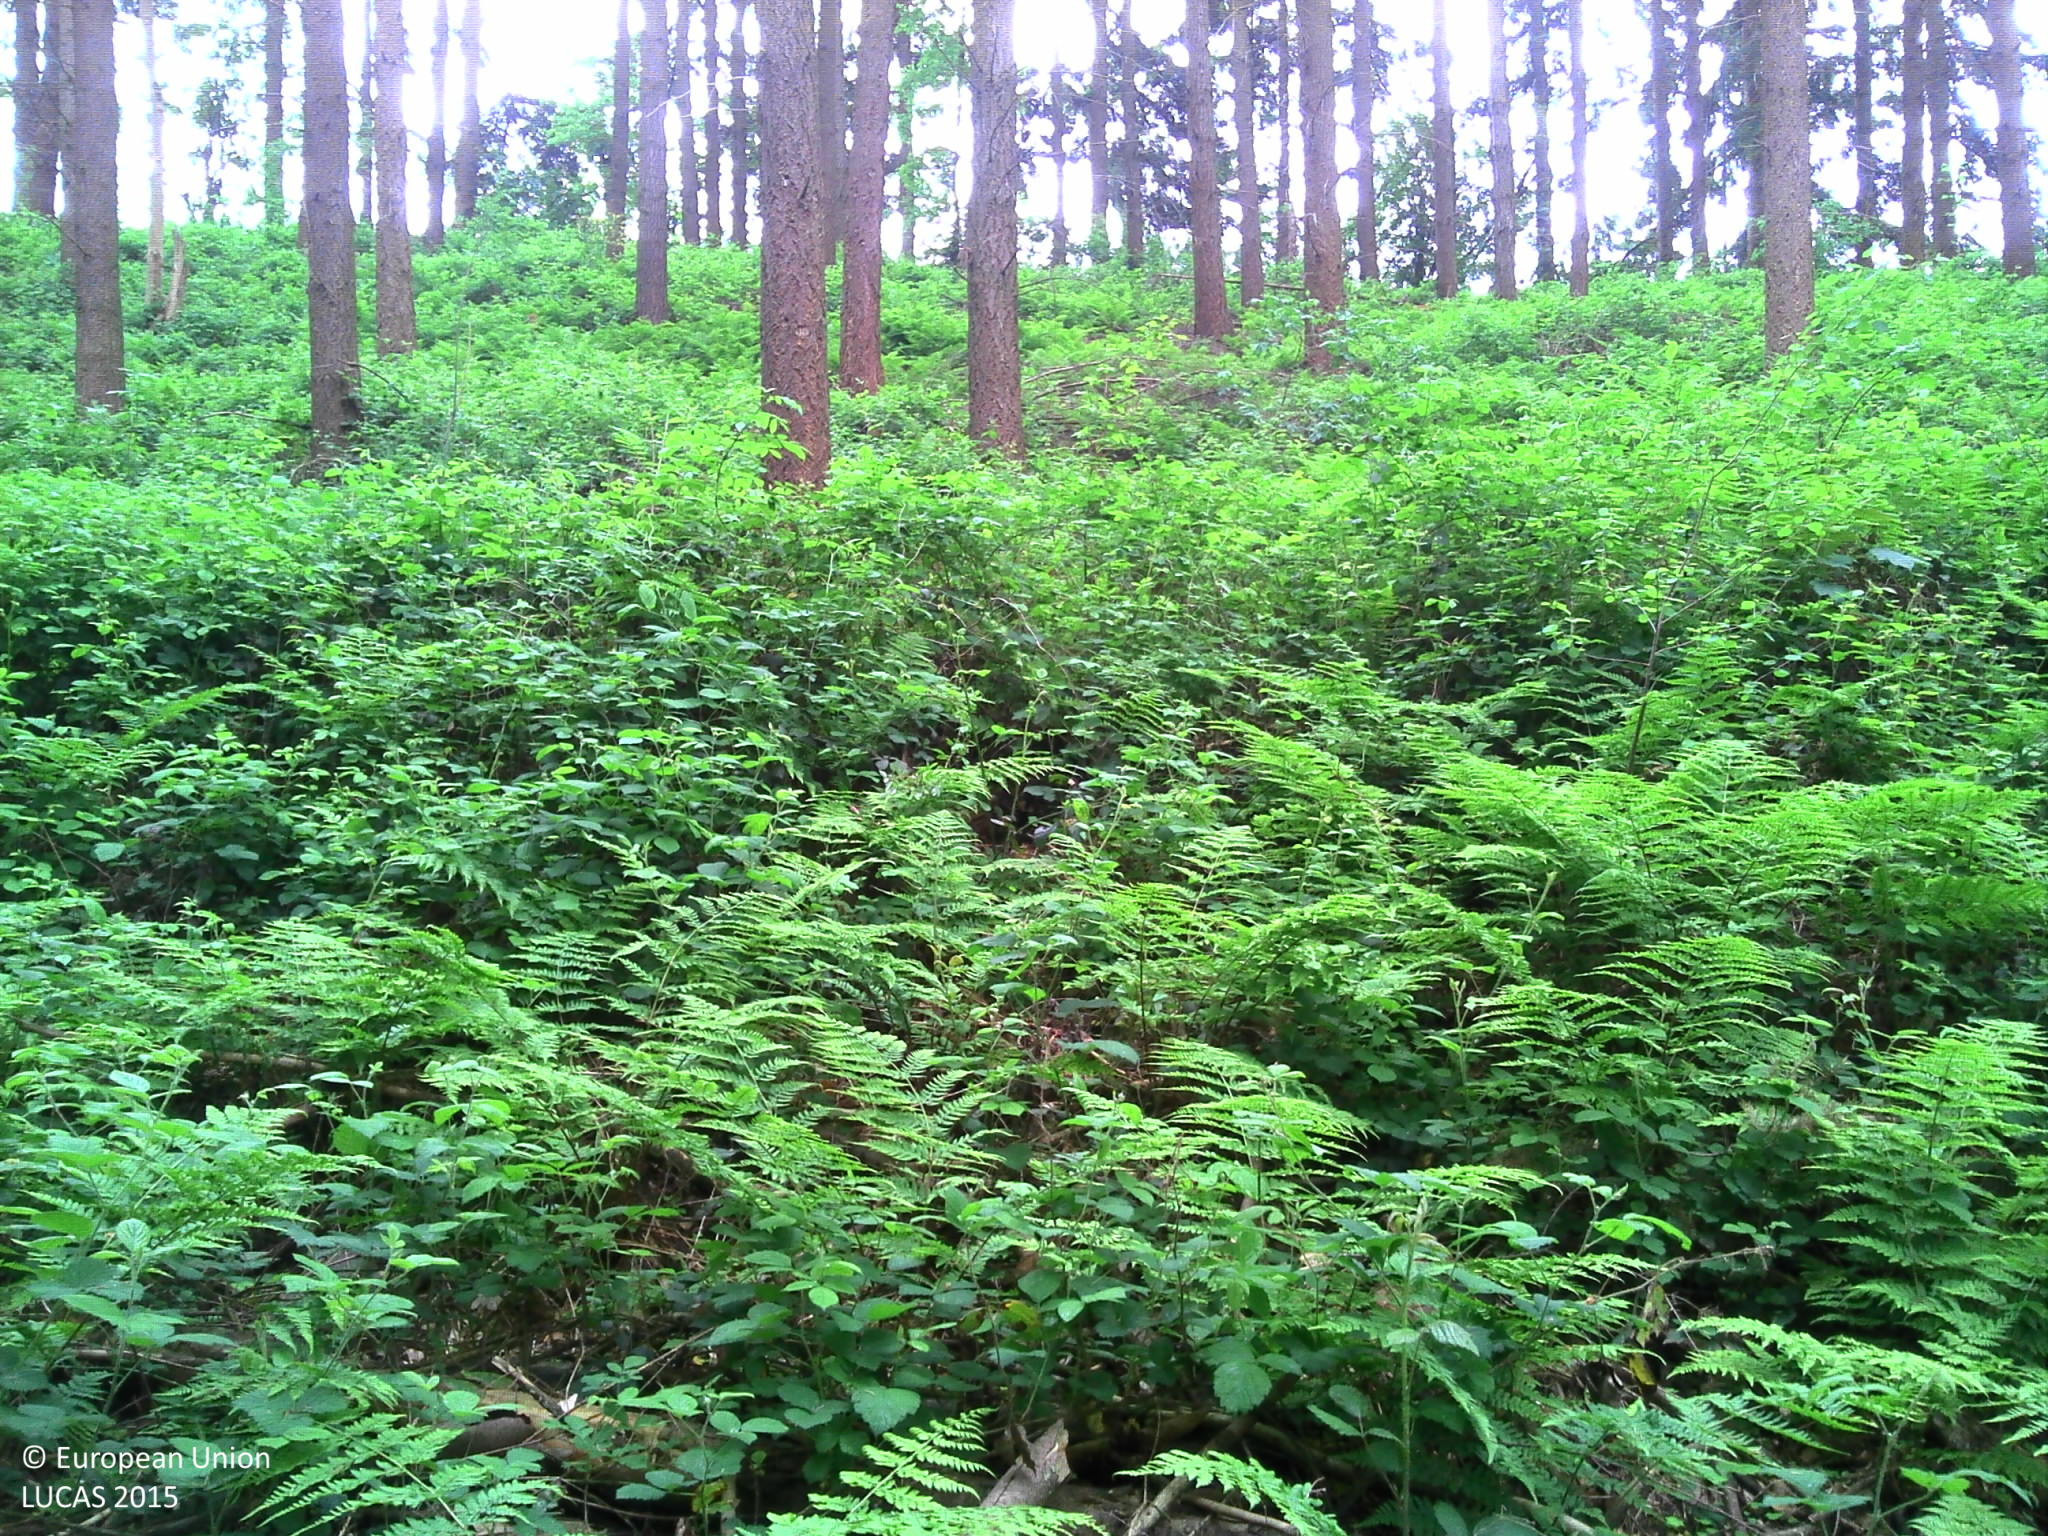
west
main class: Woodland
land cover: Other coniferous woodland
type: exotic forest
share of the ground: > 75 %
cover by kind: coniferous forest trees 90 %, herbaceous plants 10 %
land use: Forestry
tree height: > 5 m
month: June
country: BE
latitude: 50.3884
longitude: 5.6242
